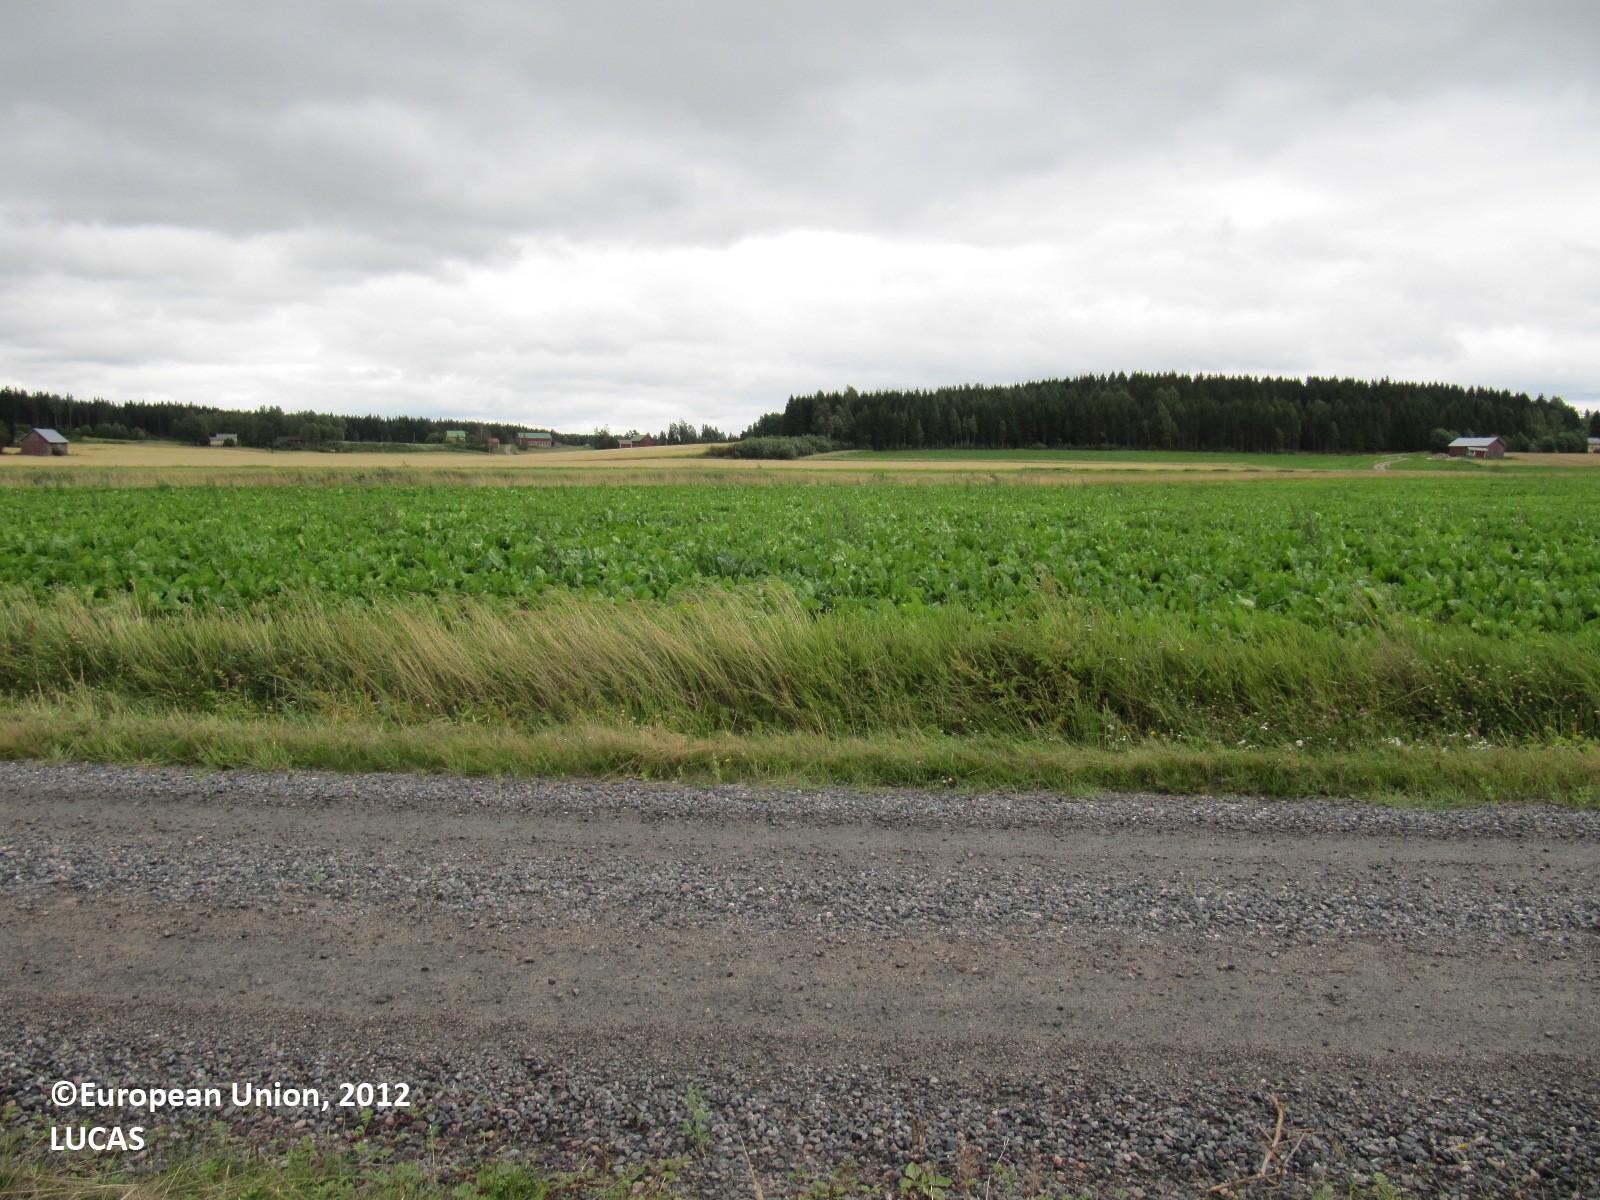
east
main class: Cropland
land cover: Oats
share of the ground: > 75 %
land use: Agriculture (excluding fallow land and kitchen gardens)
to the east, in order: Oats; Grass margins; Ditches and canals; Grass margins; Paved roads, cycling and walking lanes; Grass margins; Ditches and canals; Grass margins; Sugar beet
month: August
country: FI
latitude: 60.1785
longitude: 23.0059
